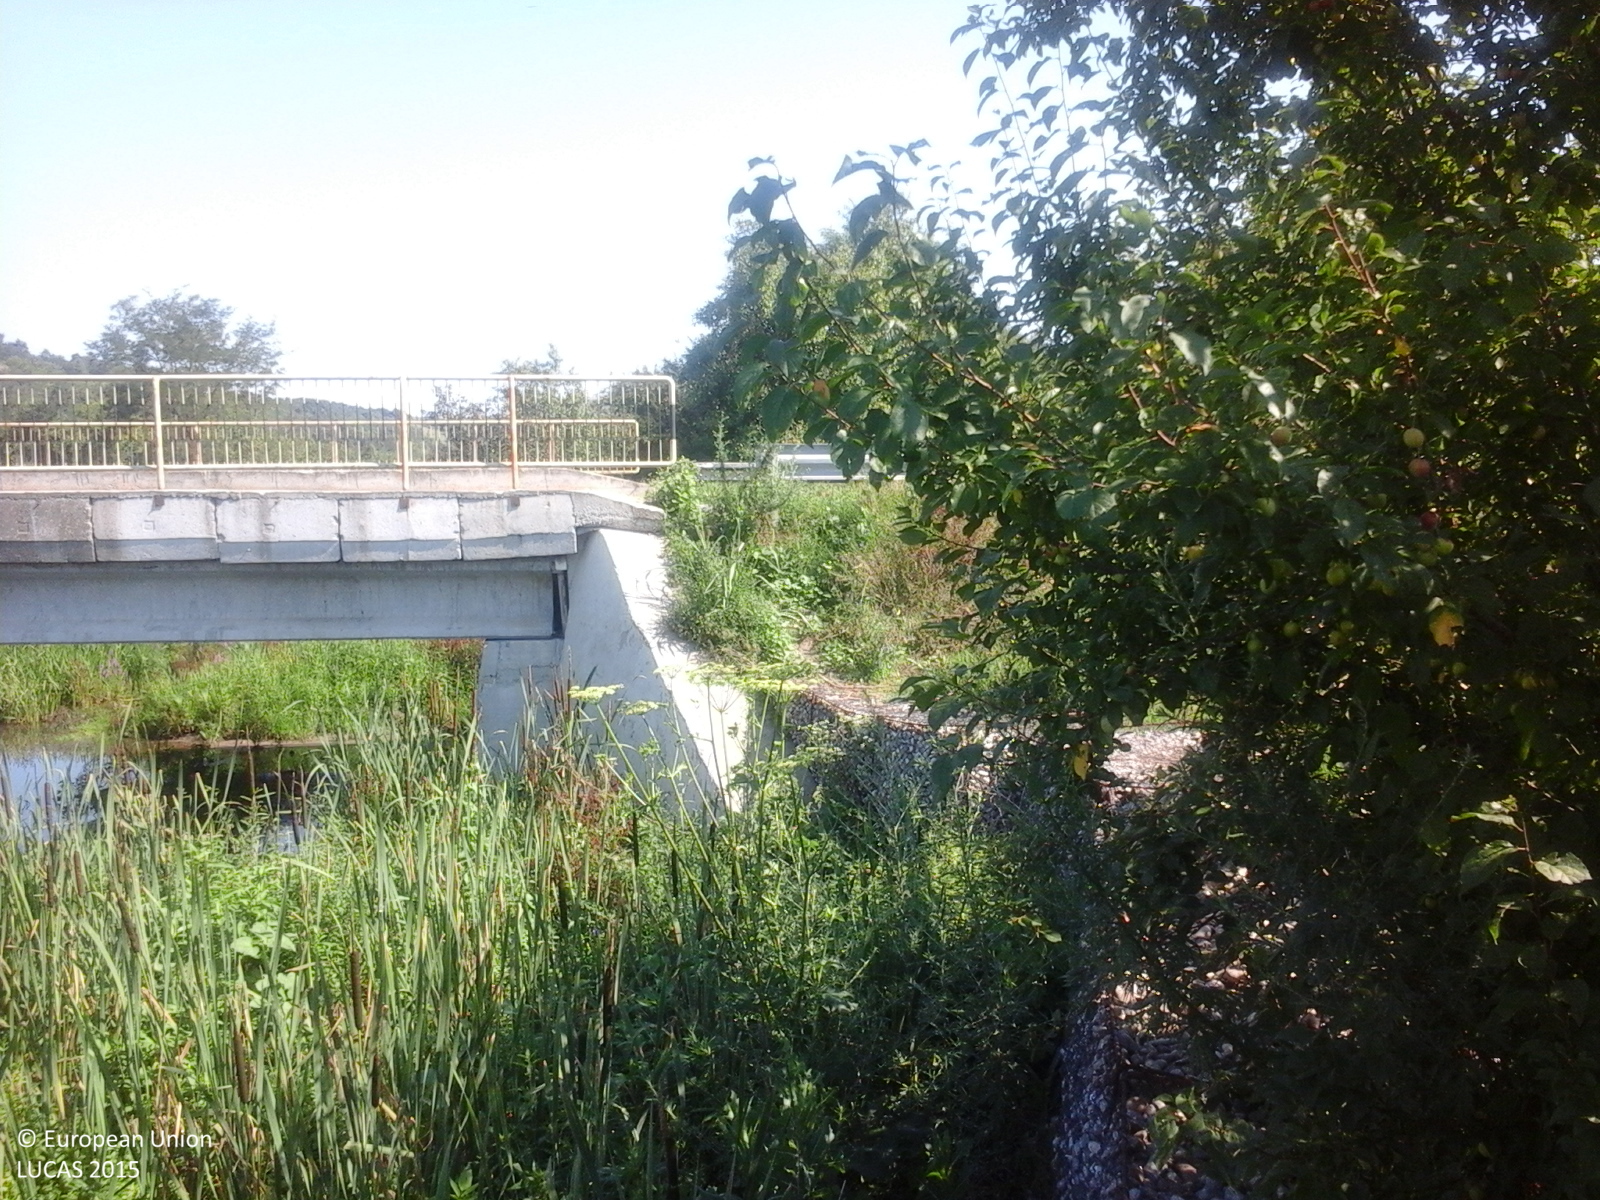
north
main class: Grassland
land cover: Spontaneously vegetated surfaces
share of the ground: > 75 %
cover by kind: herbaceous plants 100 %
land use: Semi-natural and natural areas not in use
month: July
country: RO
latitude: 44.3247
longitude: 24.5536
